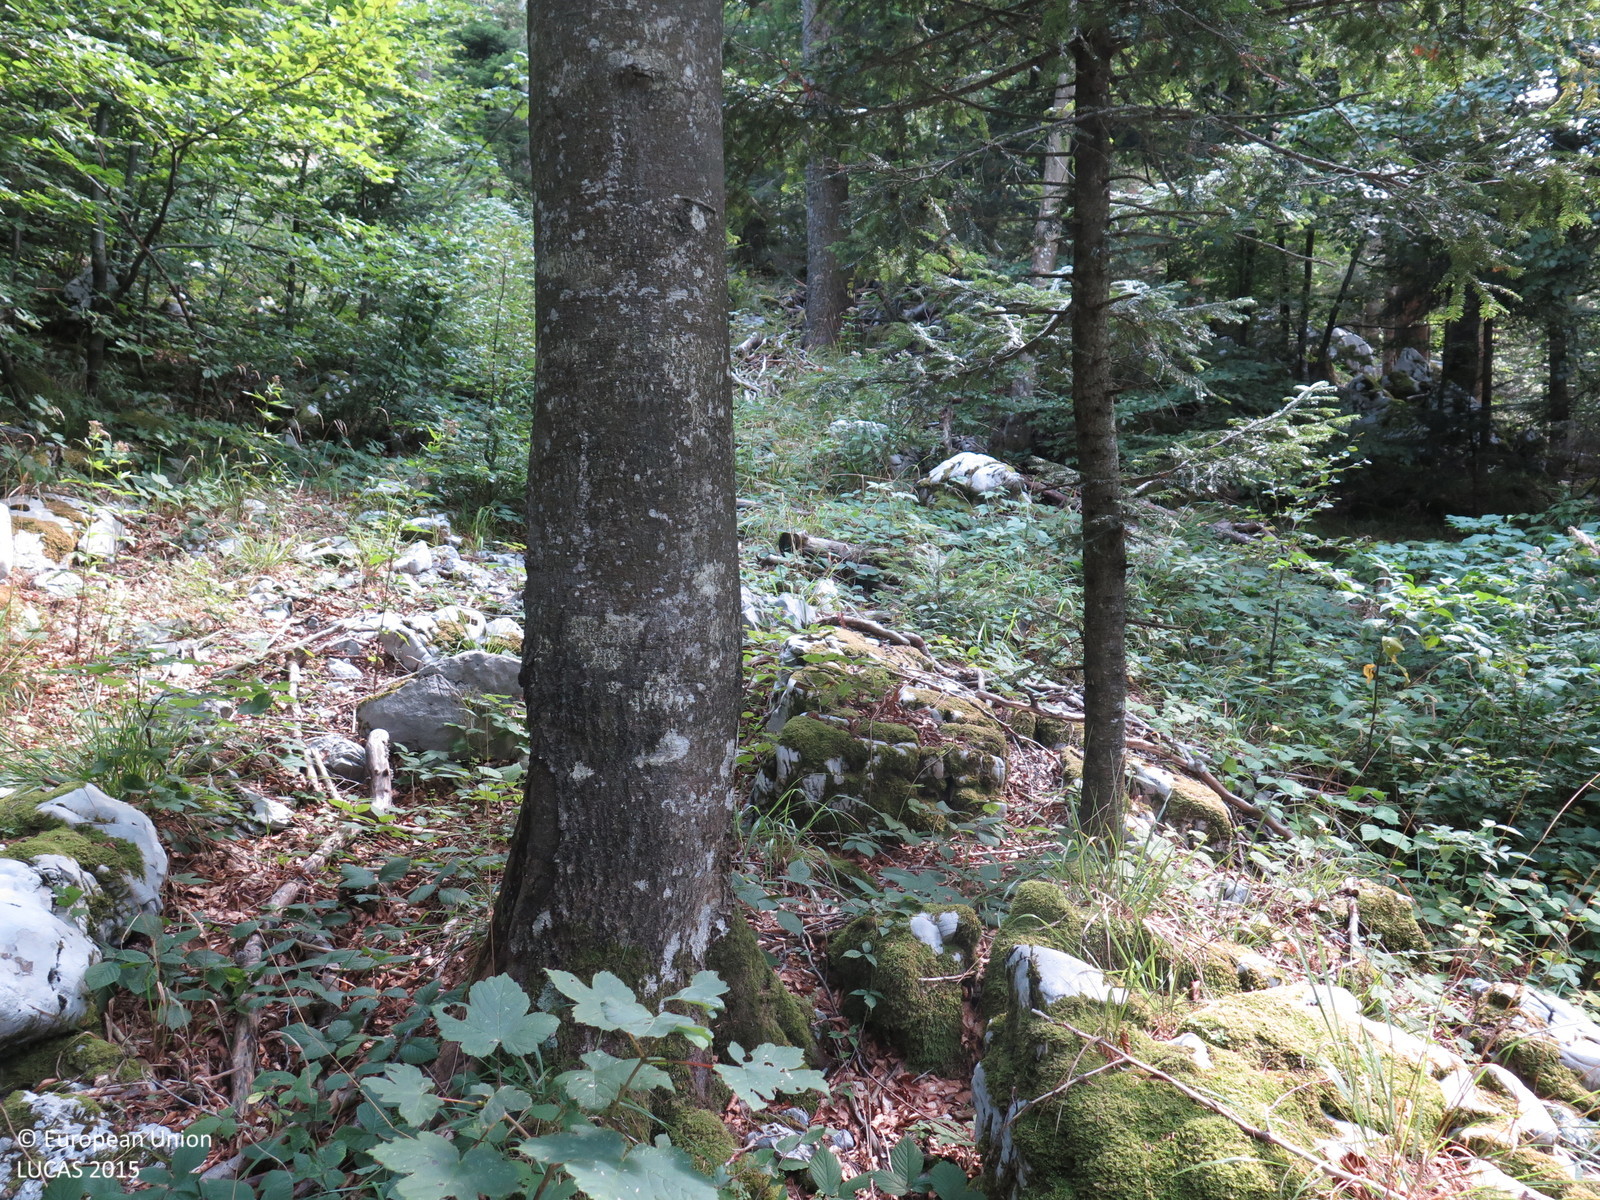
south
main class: Woodland
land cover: Other coniferous woodland
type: alpine coniferous forest
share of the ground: > 75 %
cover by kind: coniferous forest trees 75 %, broadleaved forest trees 25 %
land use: Forestry
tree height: > 5 m
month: August
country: HR
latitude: 45.1528
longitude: 14.9682
